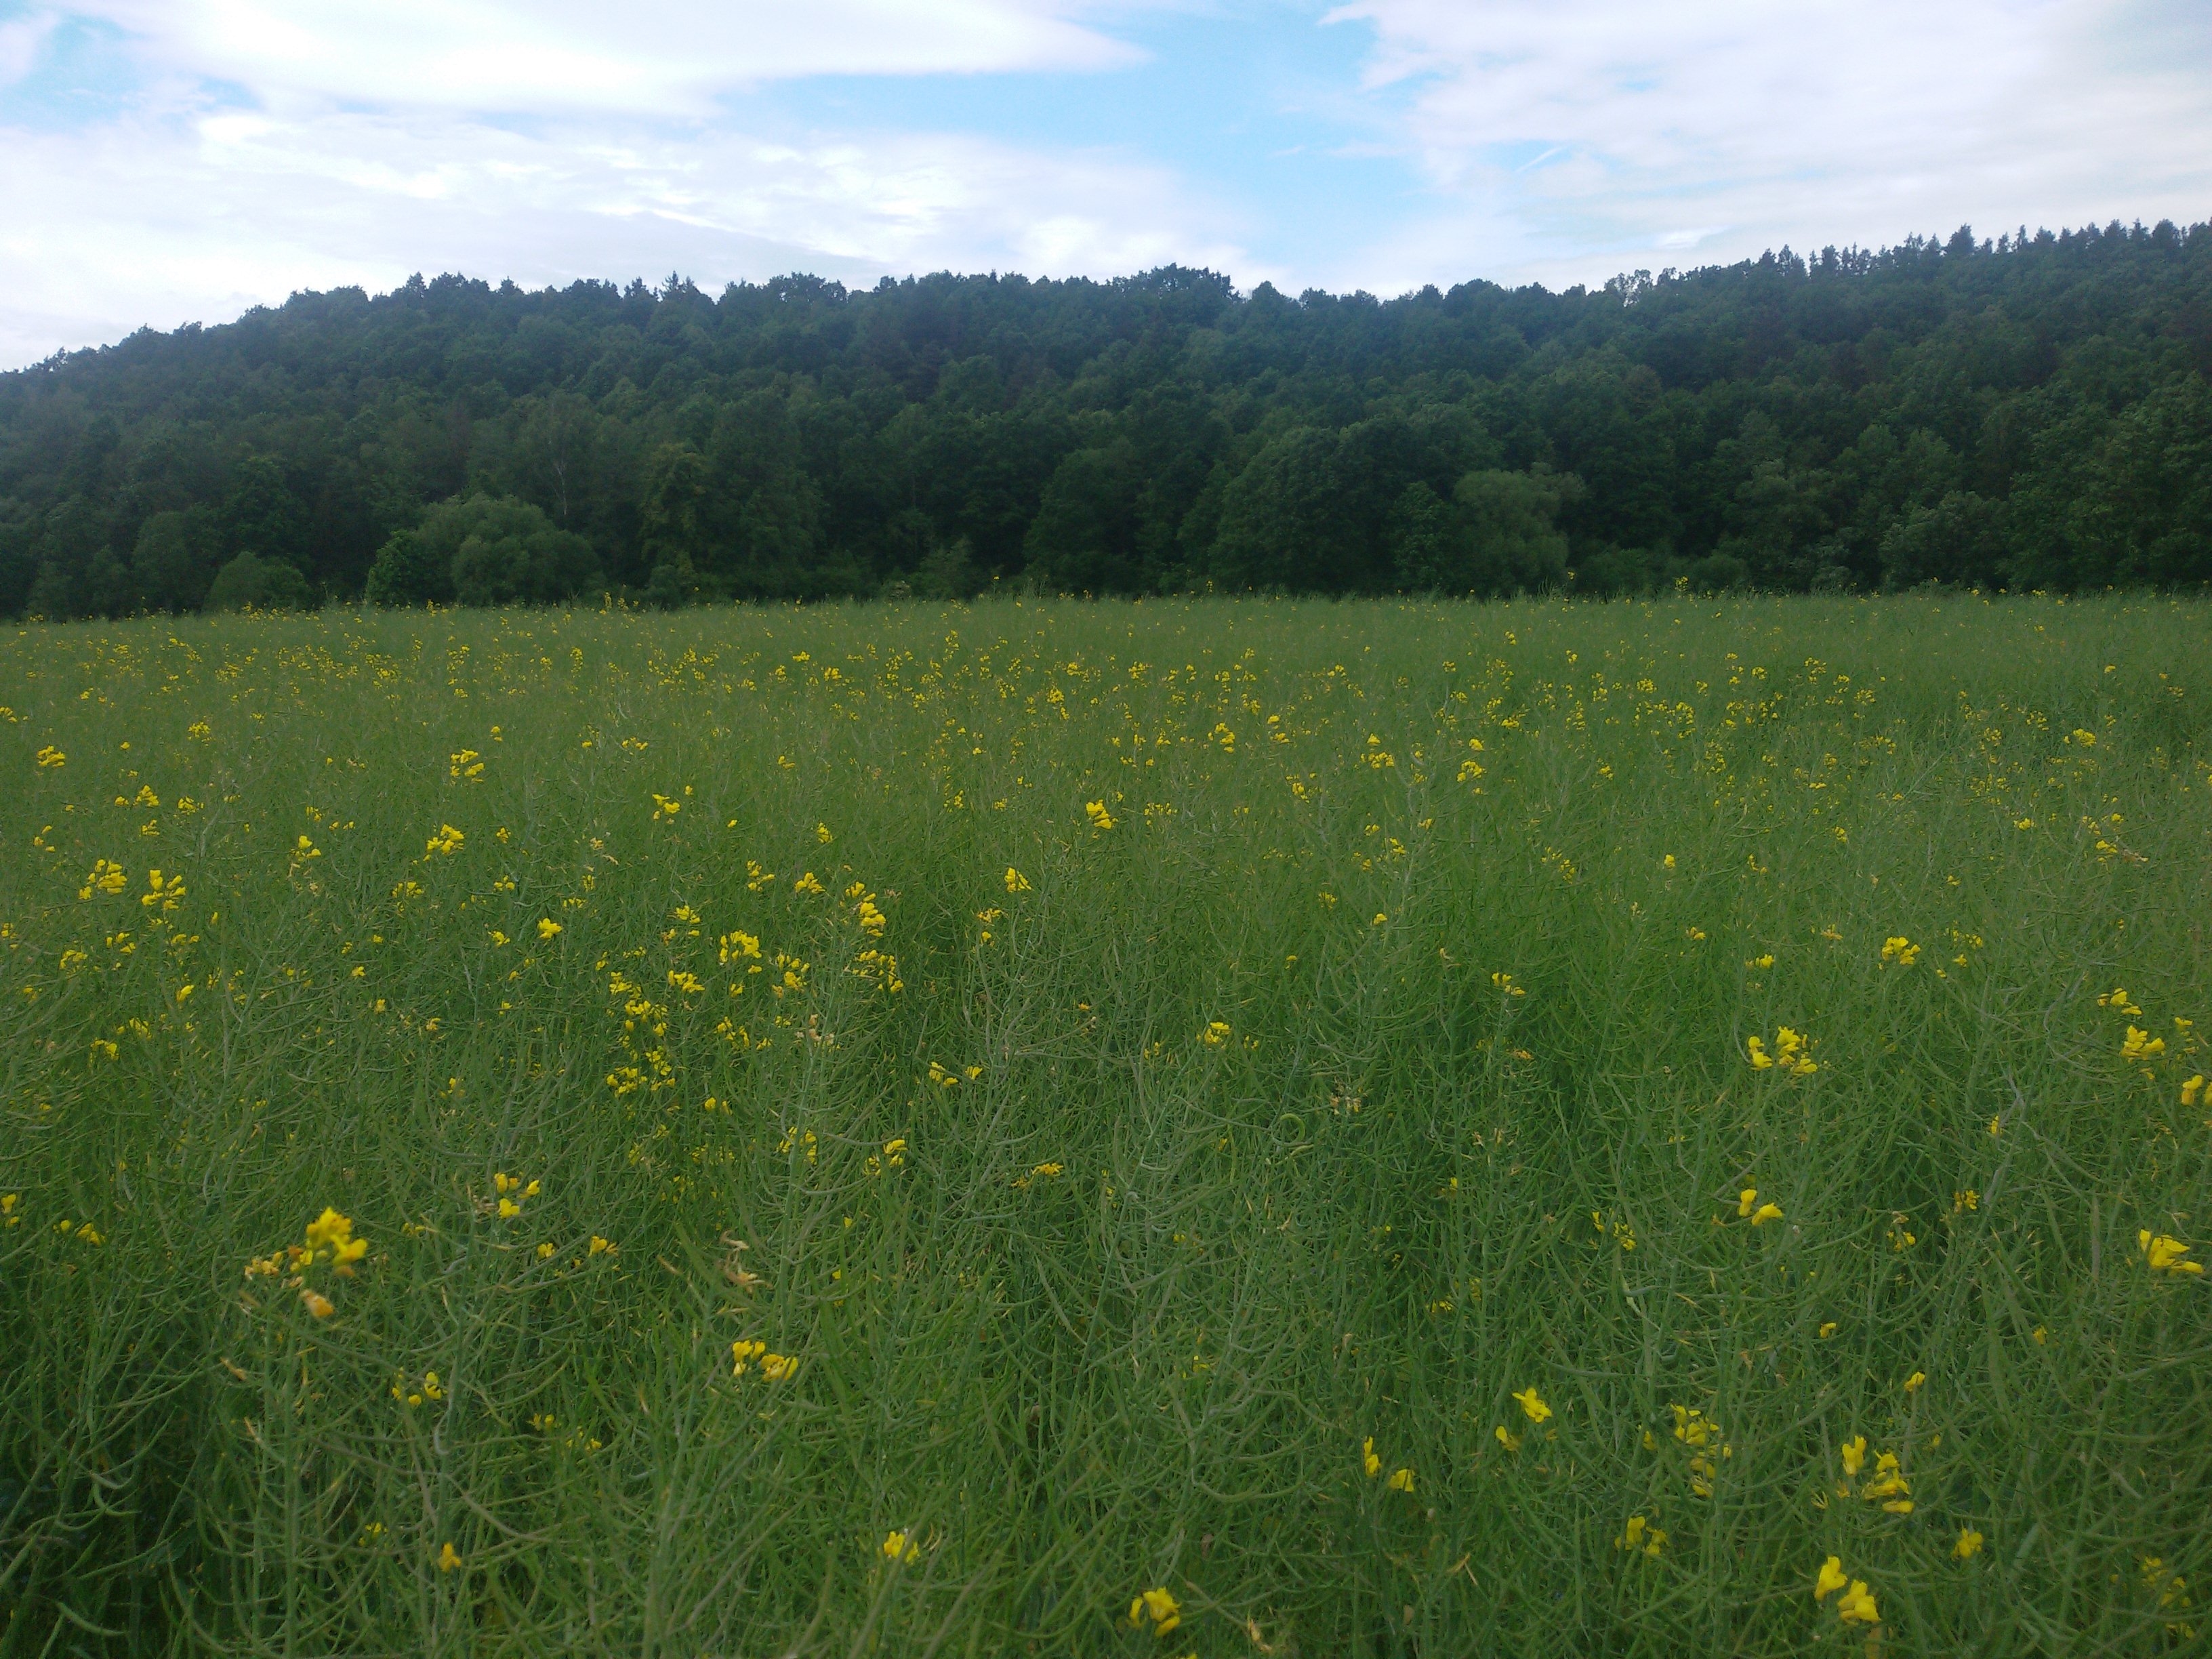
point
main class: Cropland
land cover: Rape and turnip rape
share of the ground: > 75 %
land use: Agriculture (excluding fallow land and kitchen gardens)
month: May
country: PL
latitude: 50.3881
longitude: 17.2265
